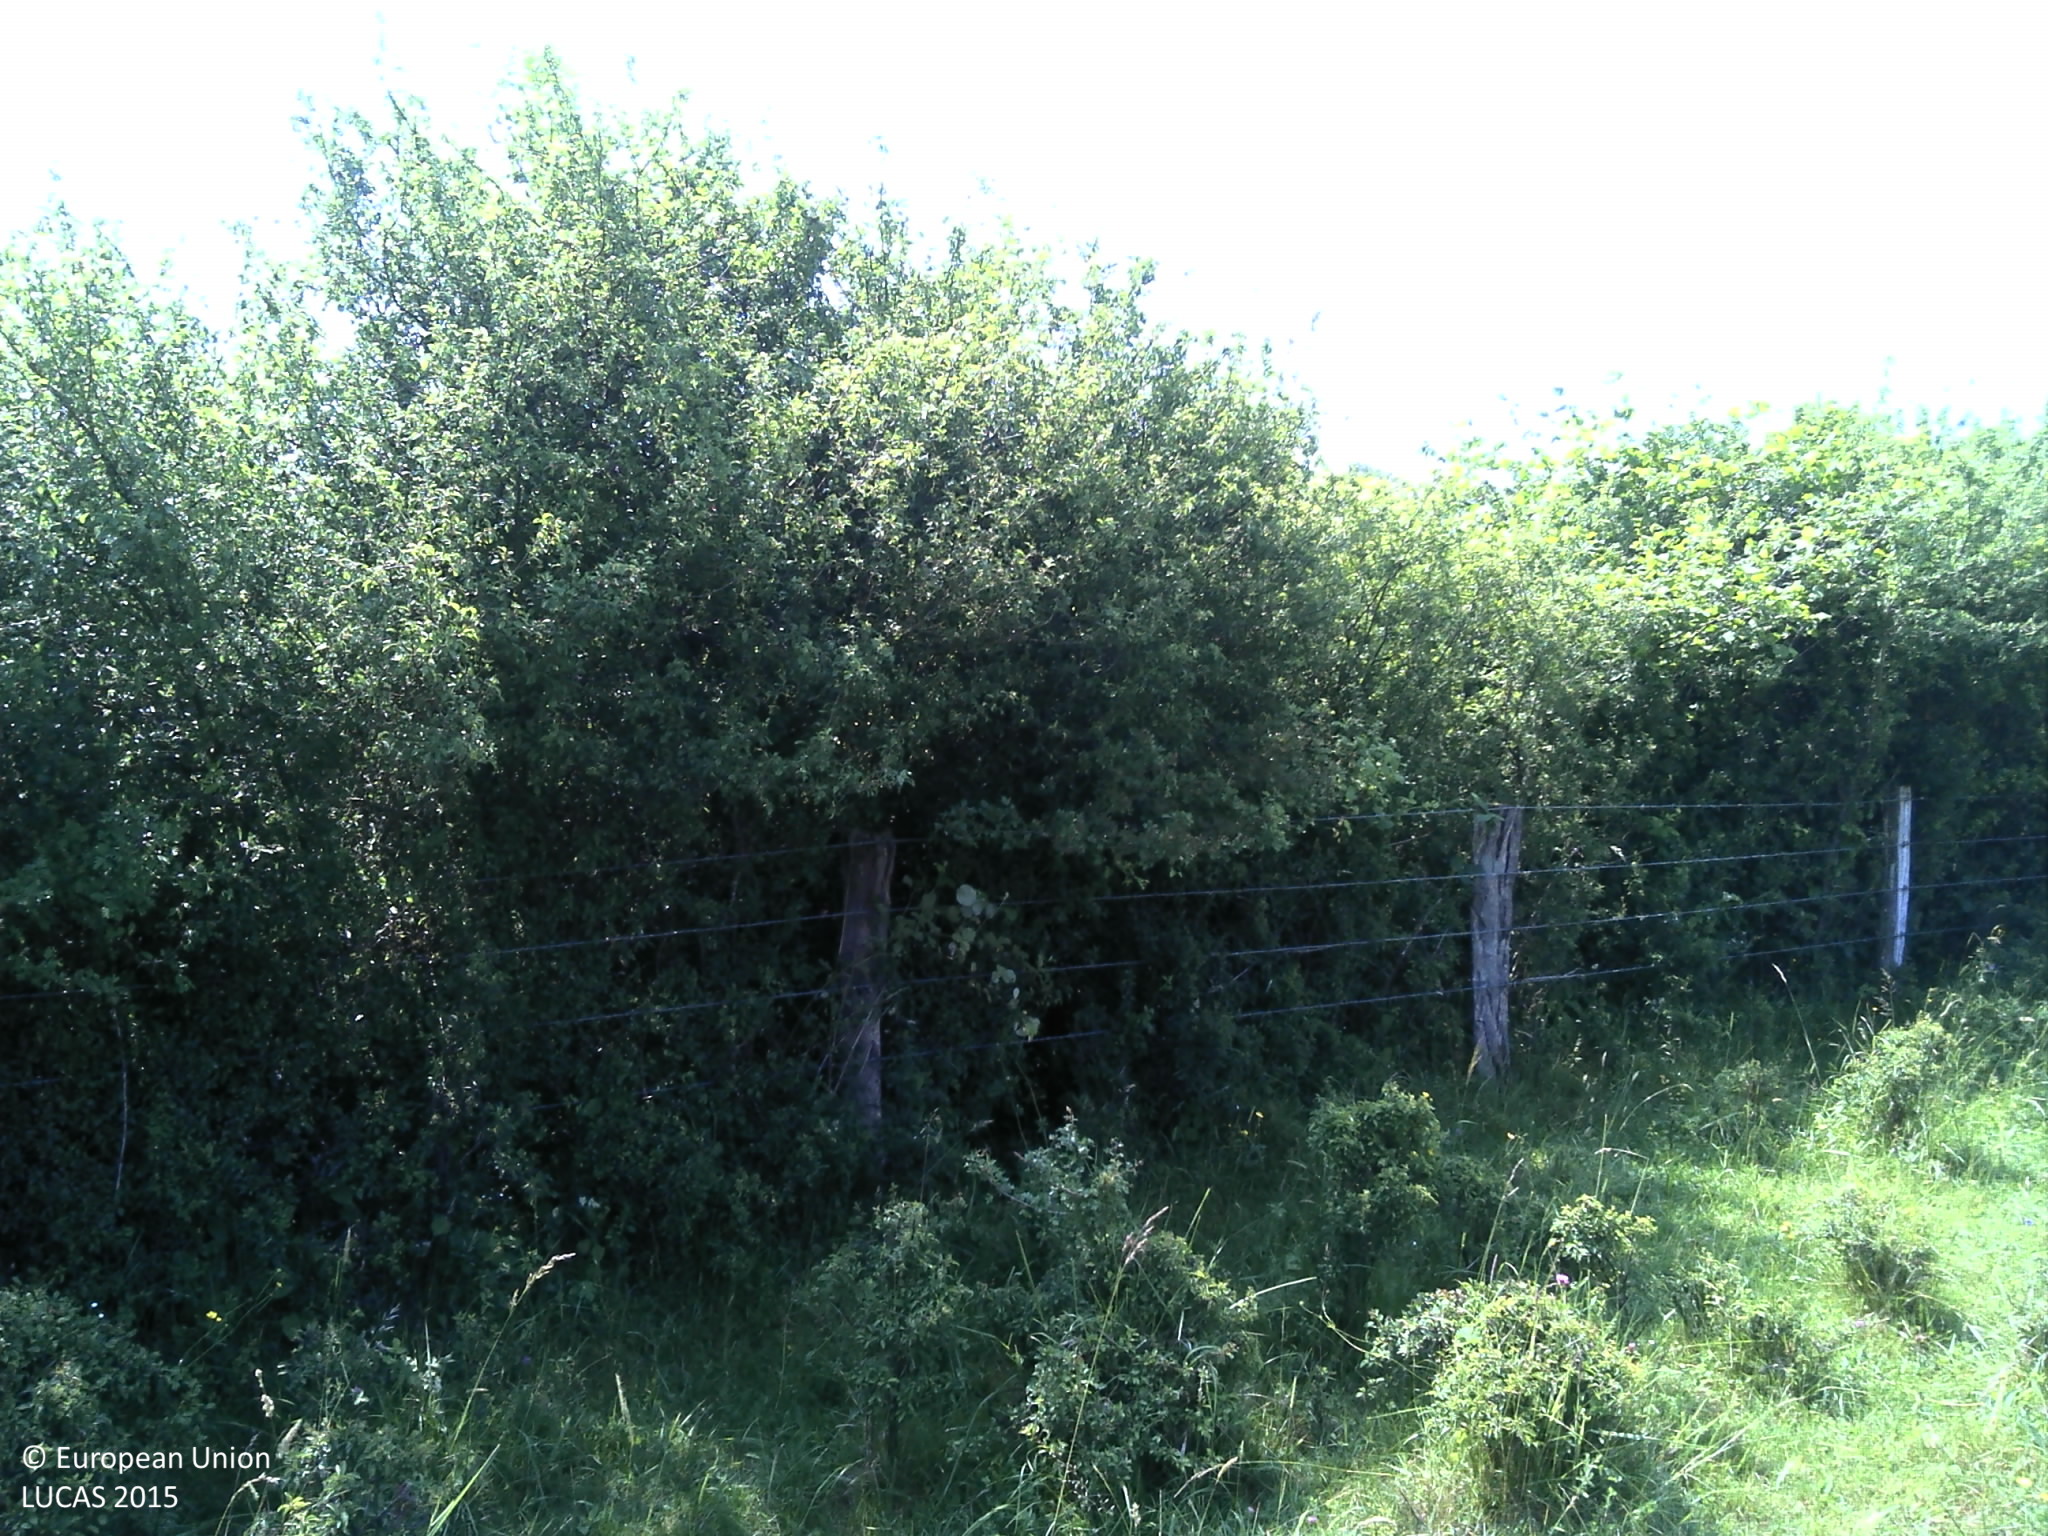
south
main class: Grassland
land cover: Grassland without tree/shrub cover
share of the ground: > 75 %
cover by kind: herbaceous plants 100 %
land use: Agriculture (excluding fallow land and kitchen gardens)
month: June
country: FR
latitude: 49.0590
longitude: 6.2090
